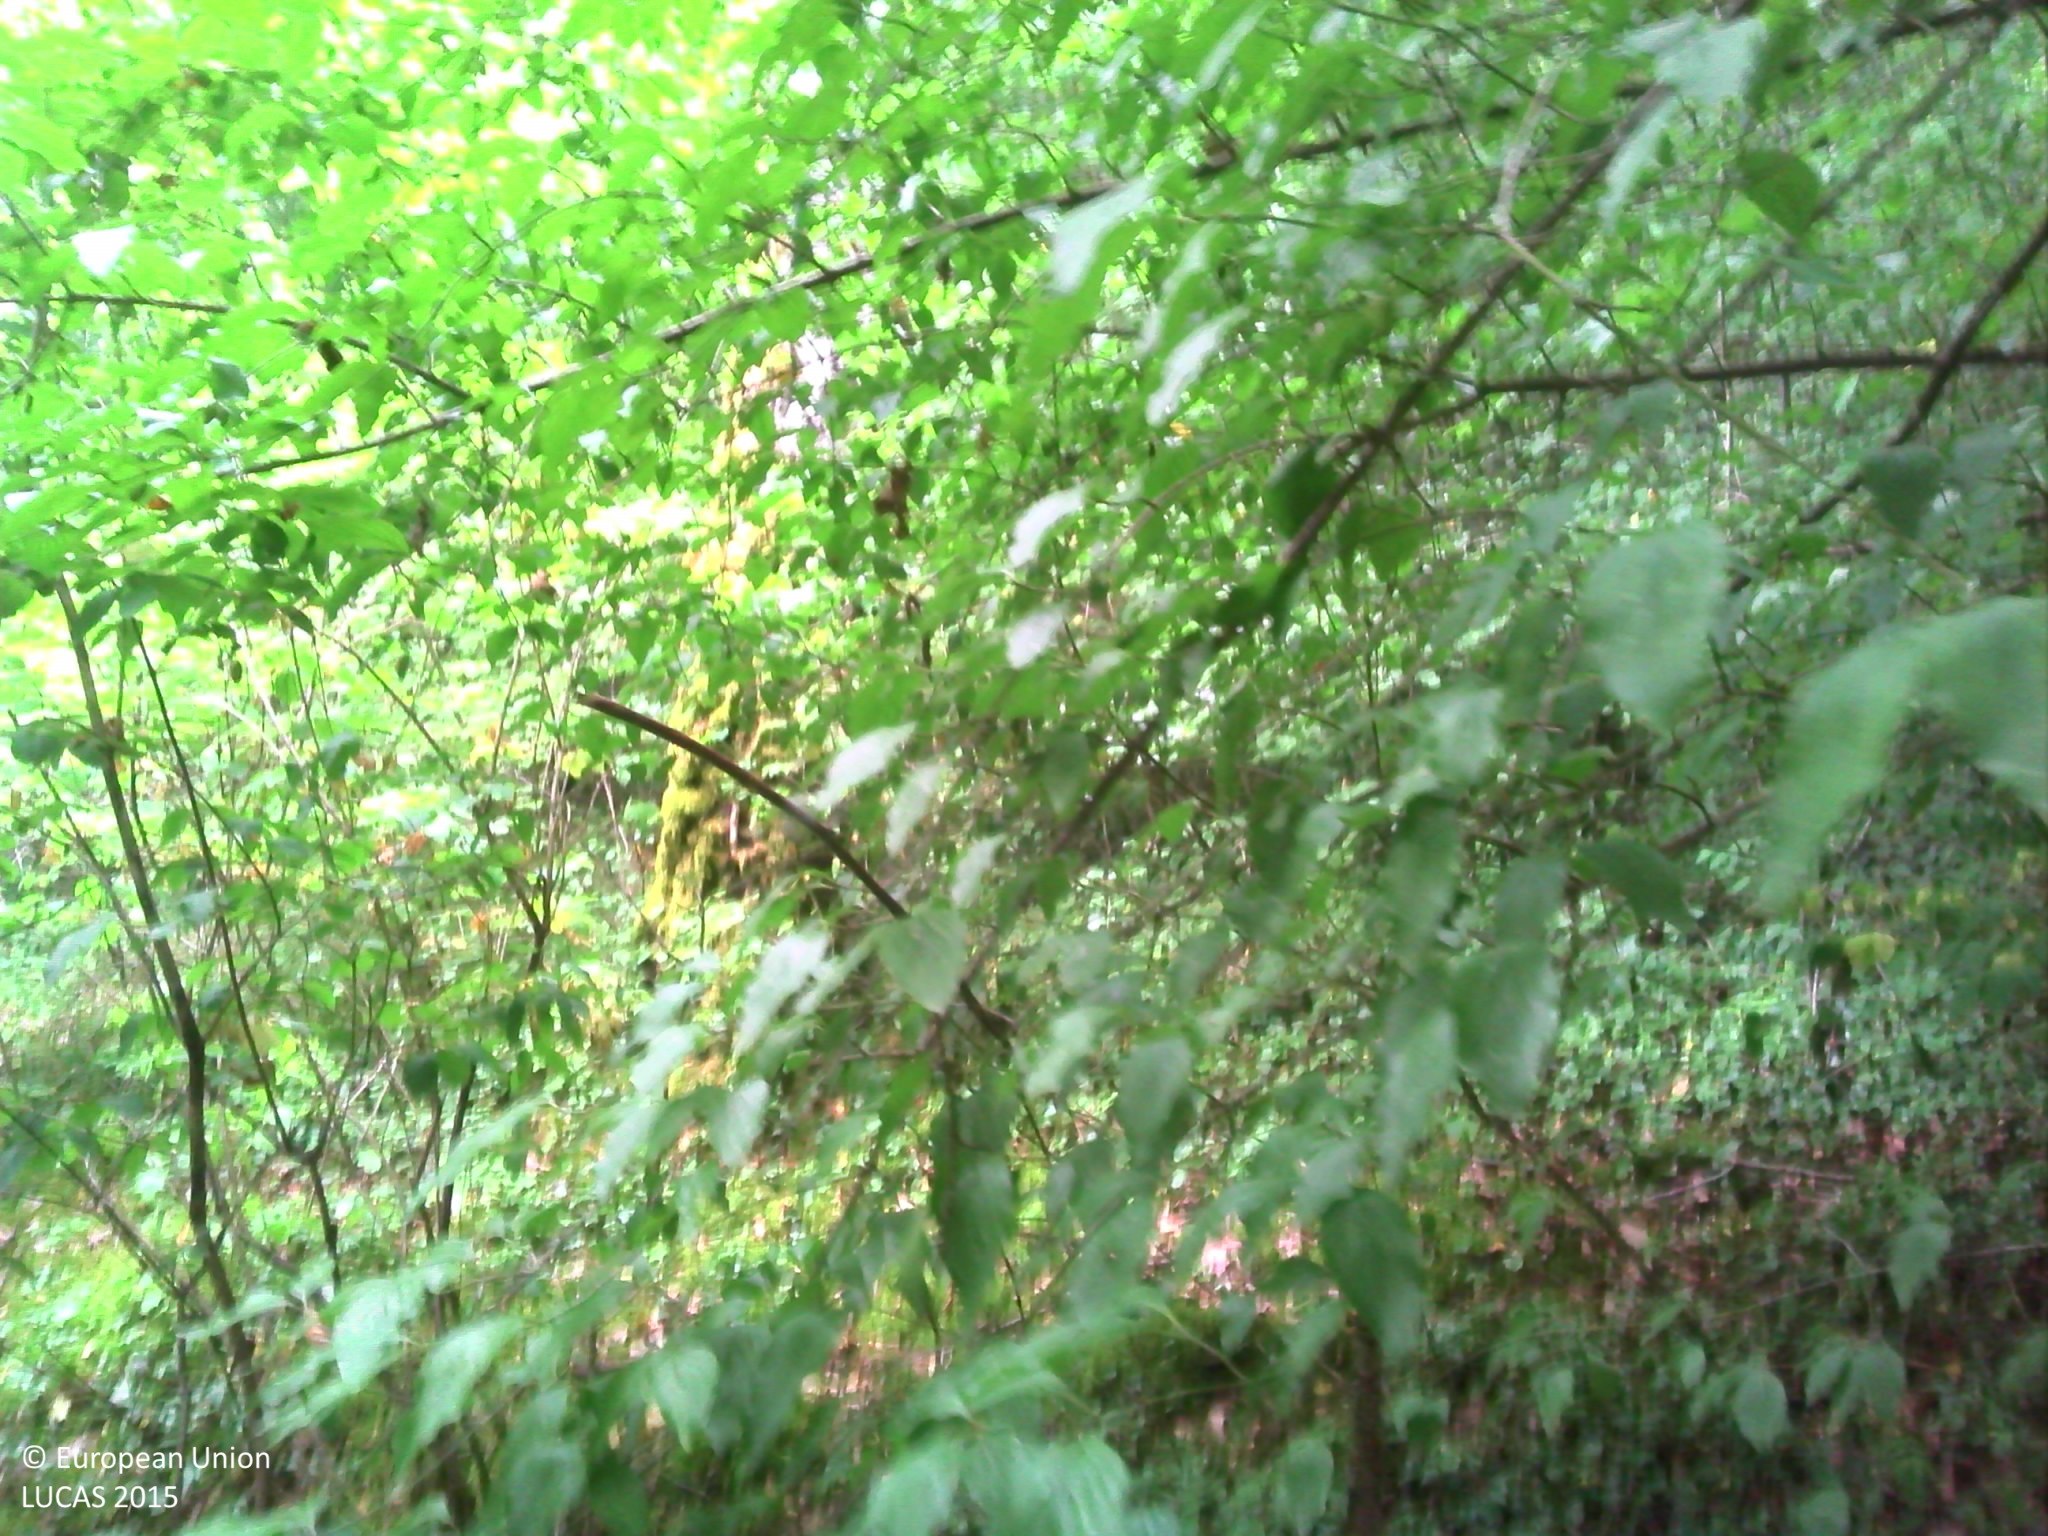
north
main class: Woodland
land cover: Broadleaved woodland
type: acidophilous oak and oak-birch forest
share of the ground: > 75 %
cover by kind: broadleaved forest trees 80 %, herbaceous plants 10 %, coniferous forest trees 5 %, lichens and mosses 5 %
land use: Forestry
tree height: > 5 m
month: July
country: FR
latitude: 48.0450
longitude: 5.1568
